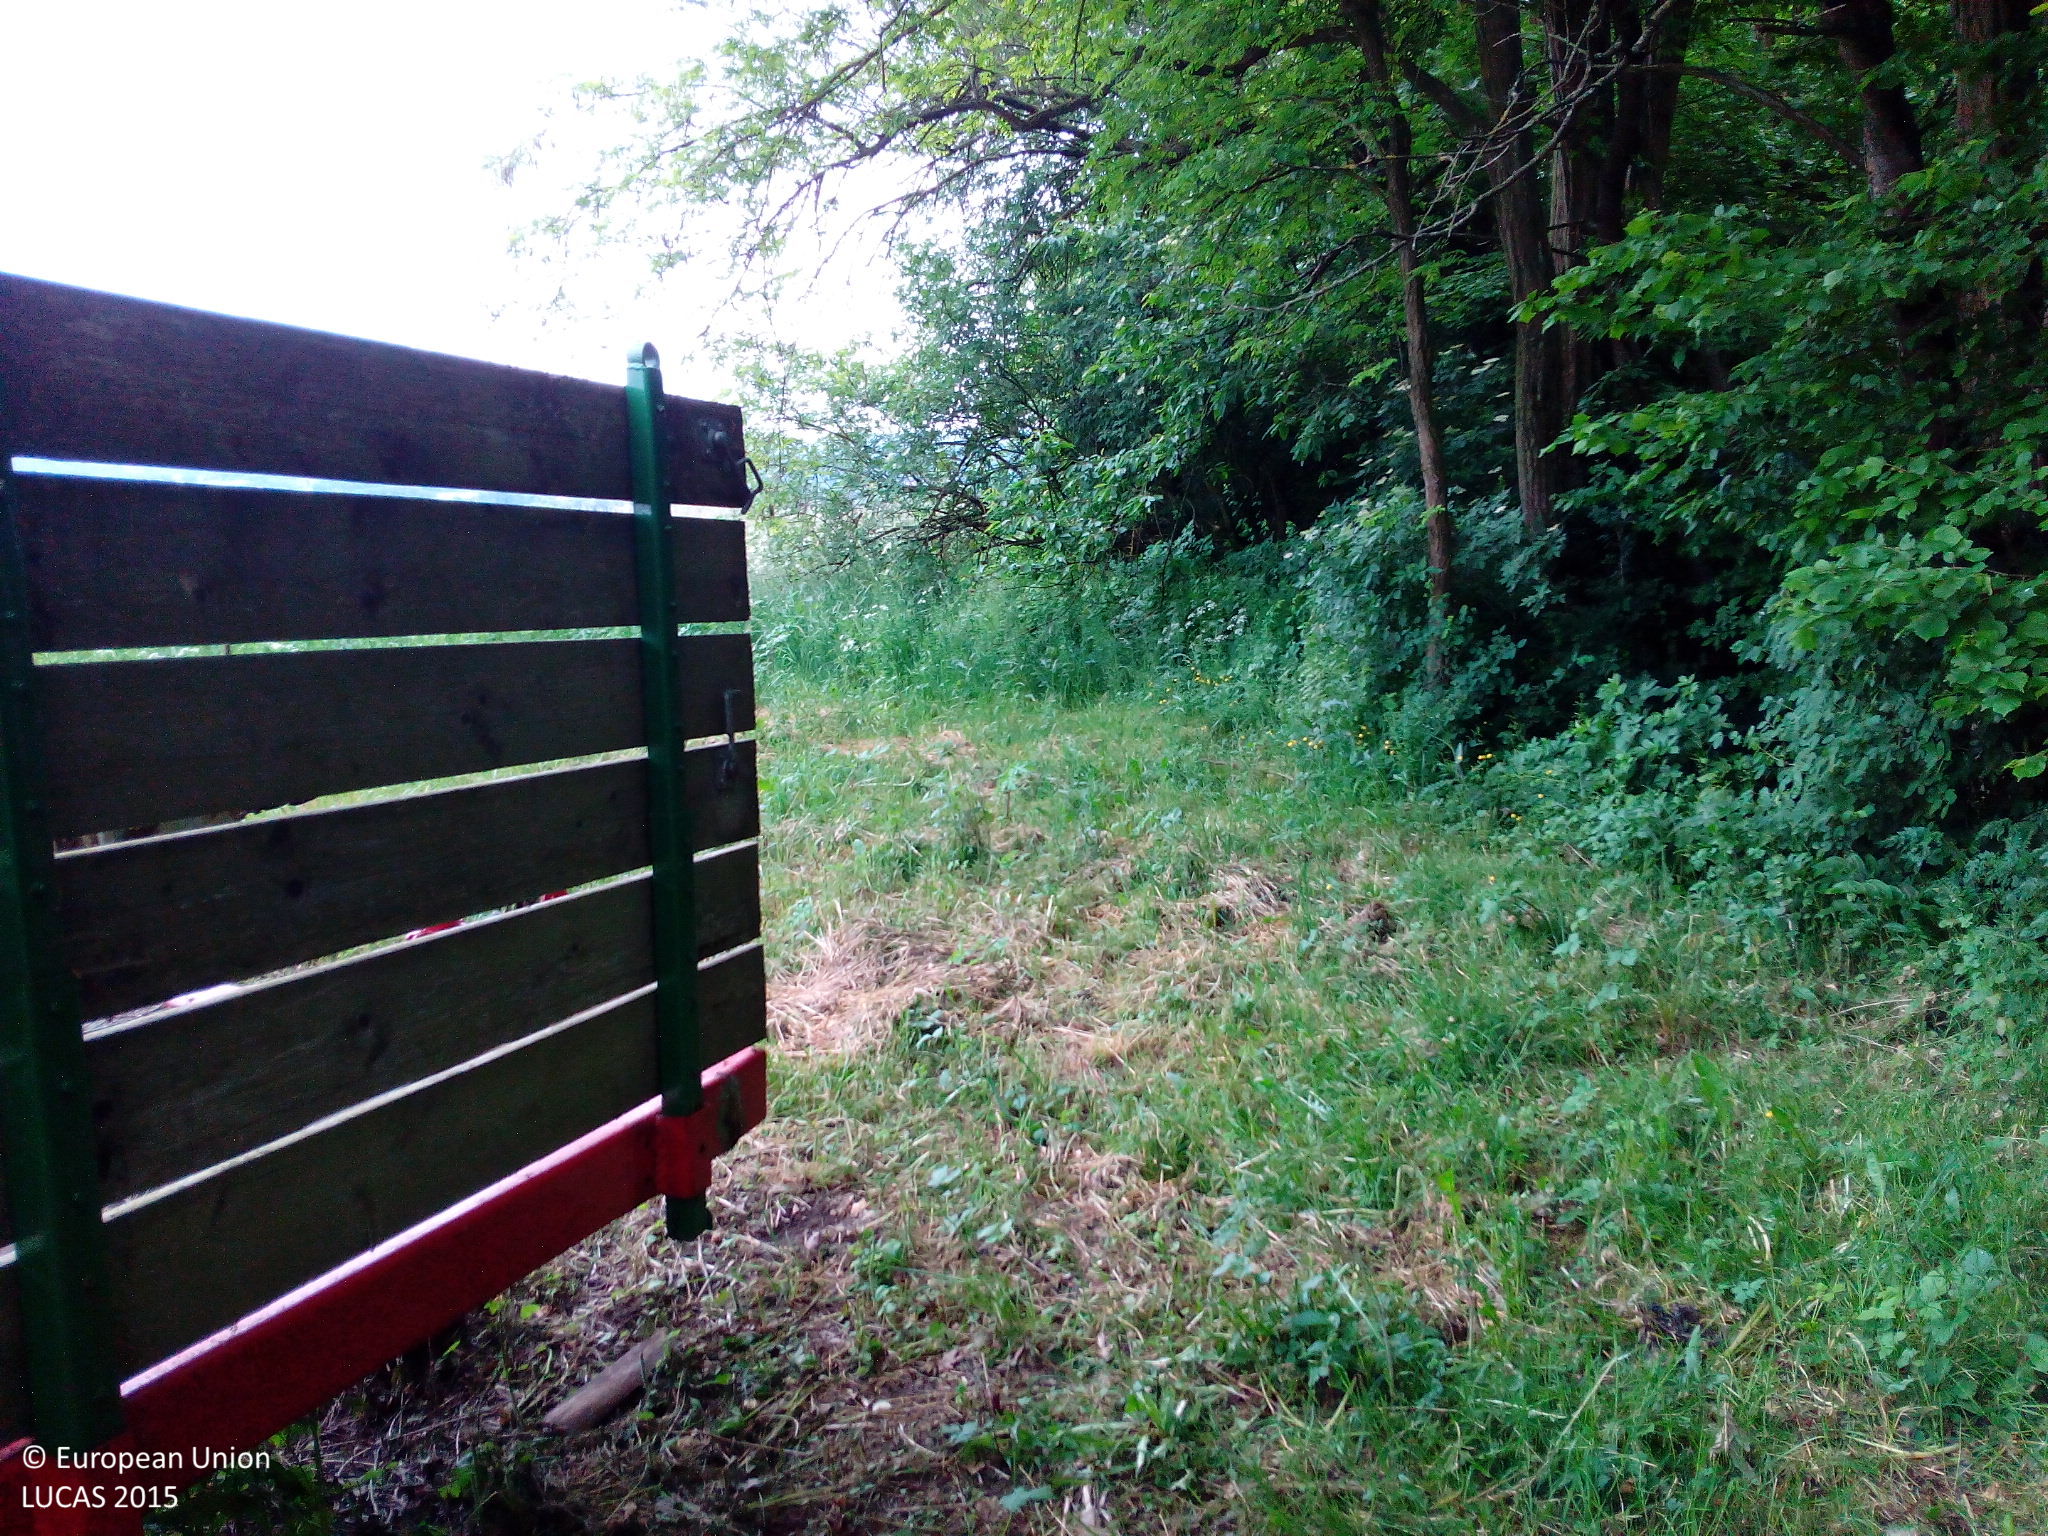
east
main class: Grassland
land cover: Grassland without tree/shrub cover
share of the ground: > 75 %
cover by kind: herbaceous plants 100 %
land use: Agriculture (excluding fallow land and kitchen gardens)
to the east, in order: Grassland without tree/shrub cover; Tracks; Grass margins; Barley
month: June
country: DE
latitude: 50.0367
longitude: 10.9072
